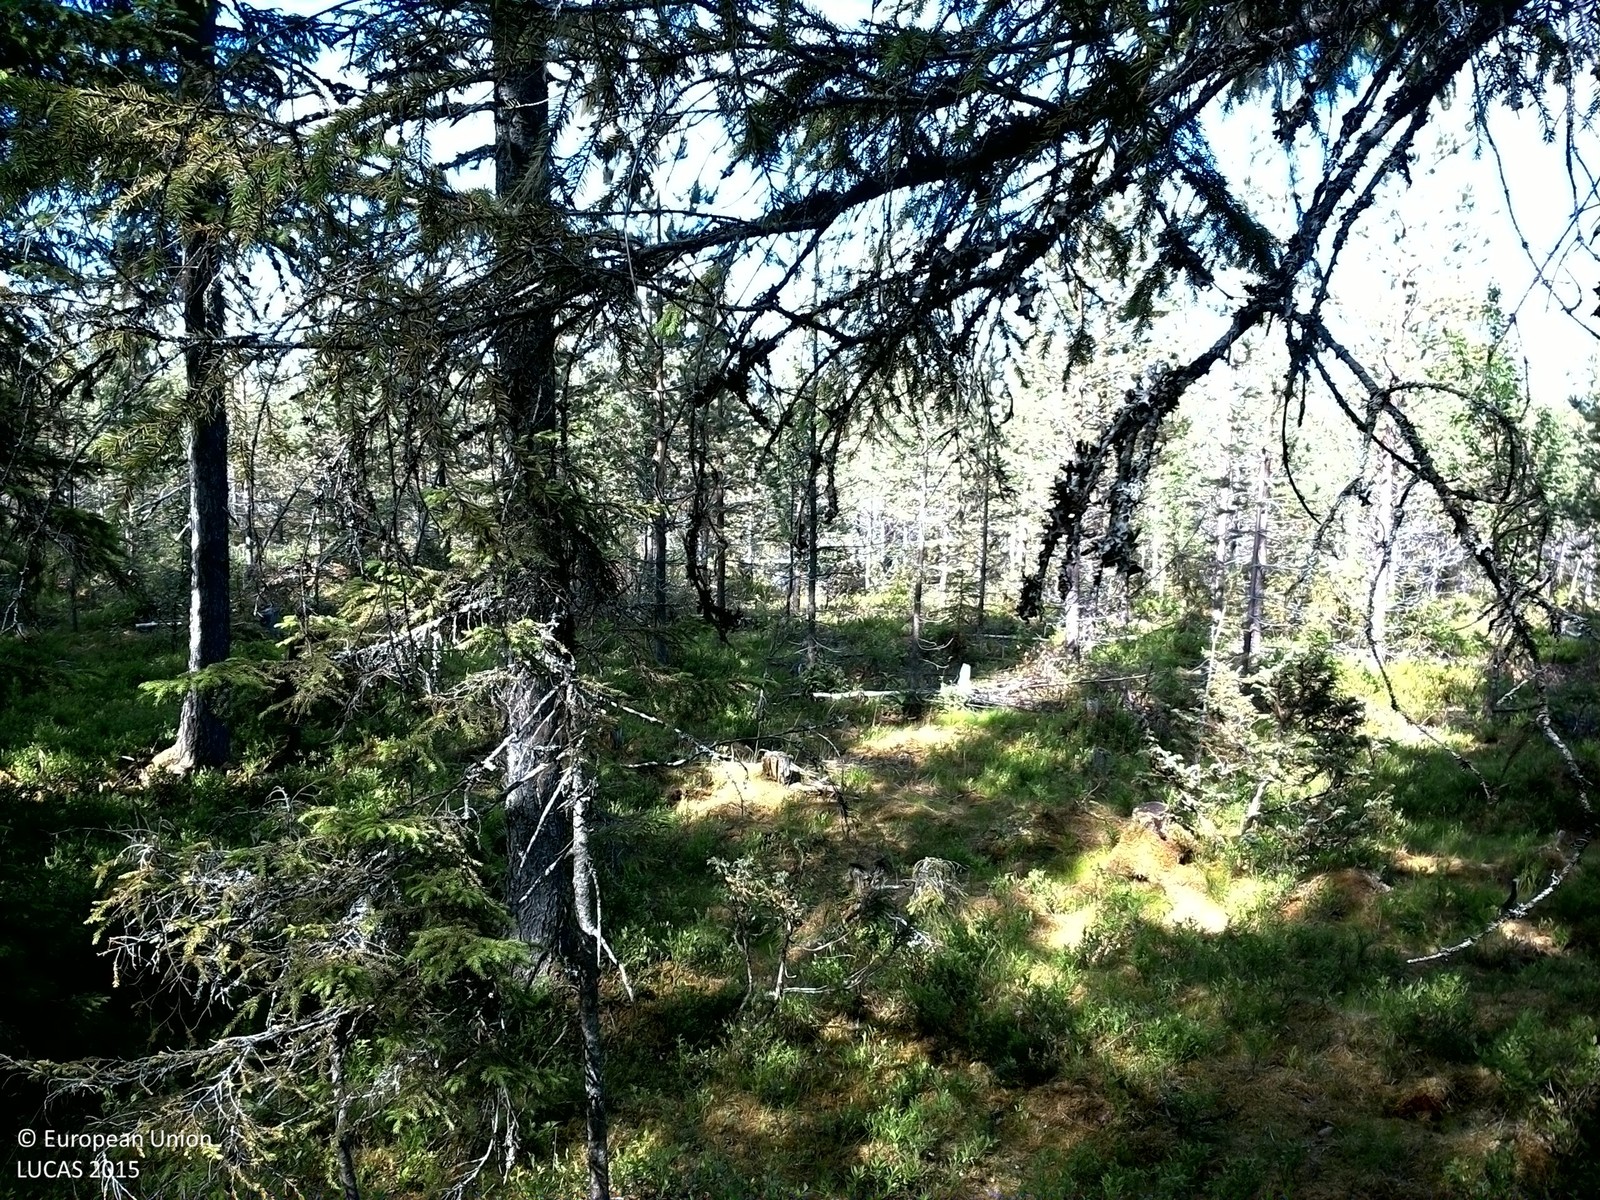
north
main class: Woodland
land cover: Spruce dominated coniferous woodland
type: boreal forest
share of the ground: > 75 %
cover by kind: coniferous forest trees 75 %, shrubs 20 %, herbaceous plants 5 %
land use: Forestry
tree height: > 5 m
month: July
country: SE
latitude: 64.5626
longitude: 15.8323
